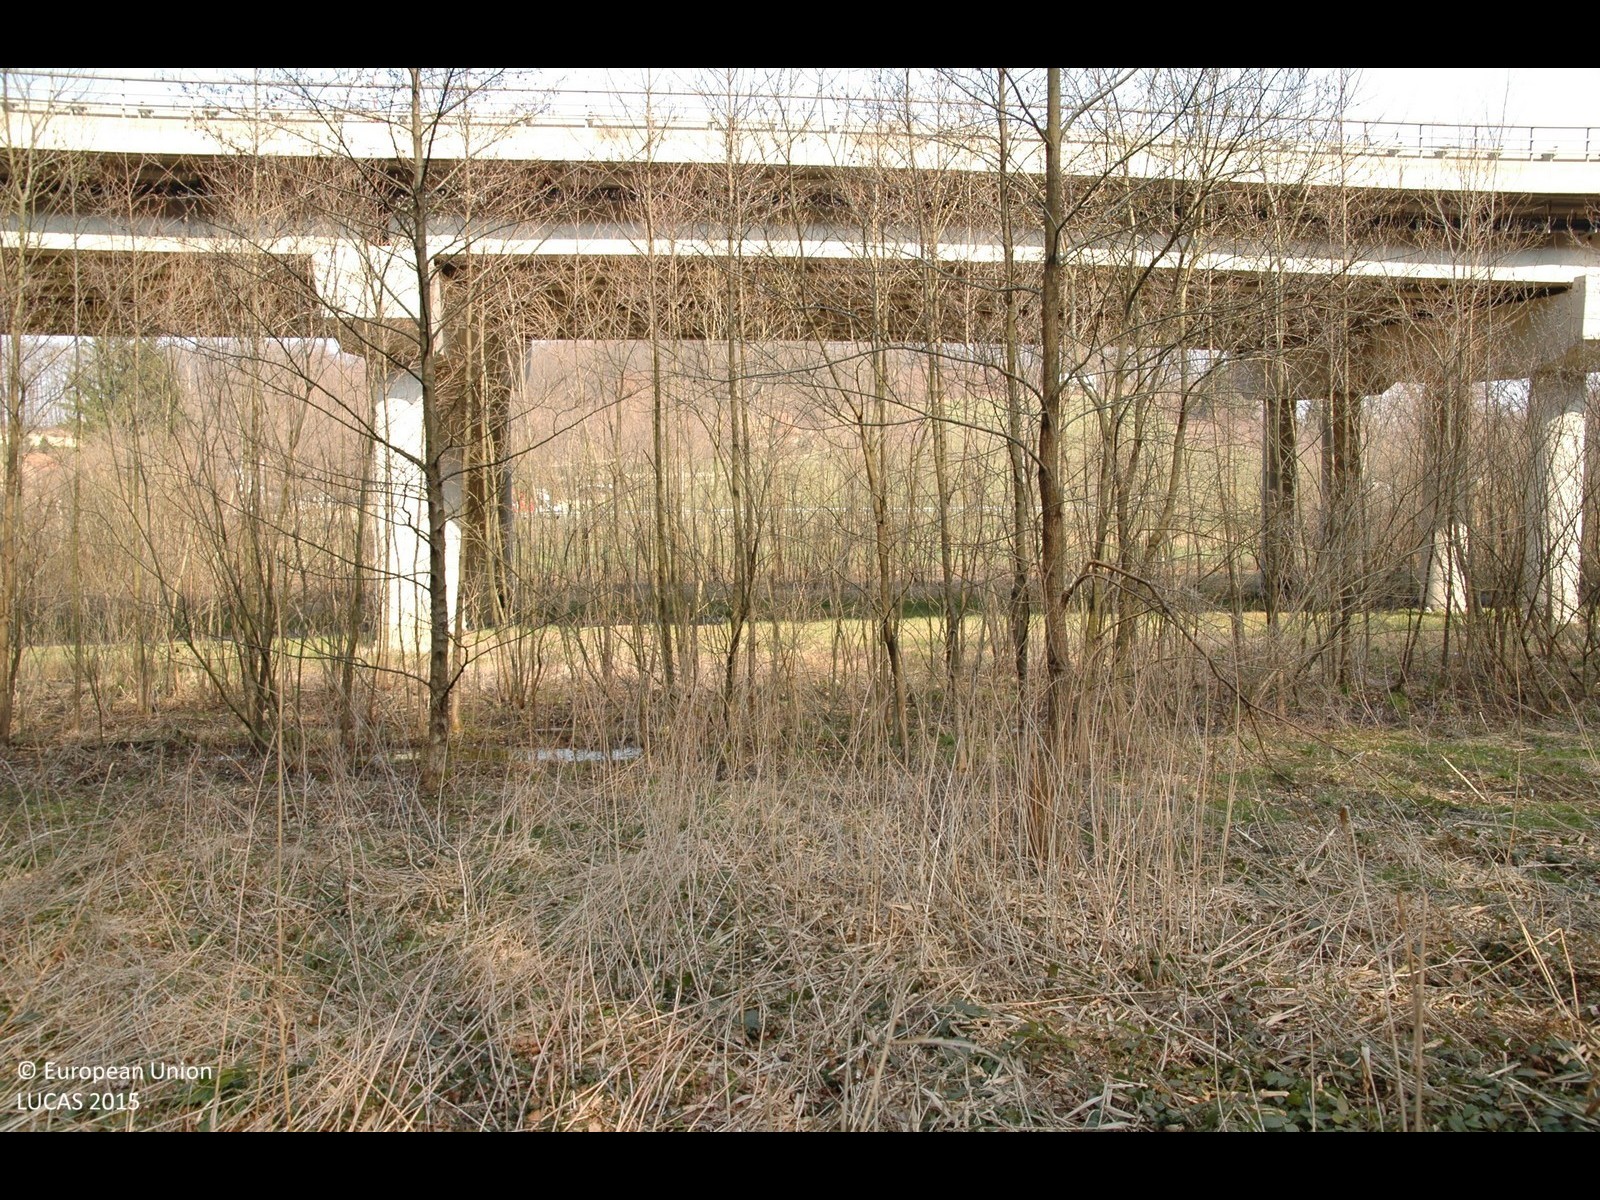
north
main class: Woodland
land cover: Broadleaved woodland
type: mesophytic deciduous forest
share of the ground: > 75 %
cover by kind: broadleaved forest trees 90 %
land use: Forestry
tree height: > 5 m
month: March
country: HR
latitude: 46.1277
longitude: 16.3284
